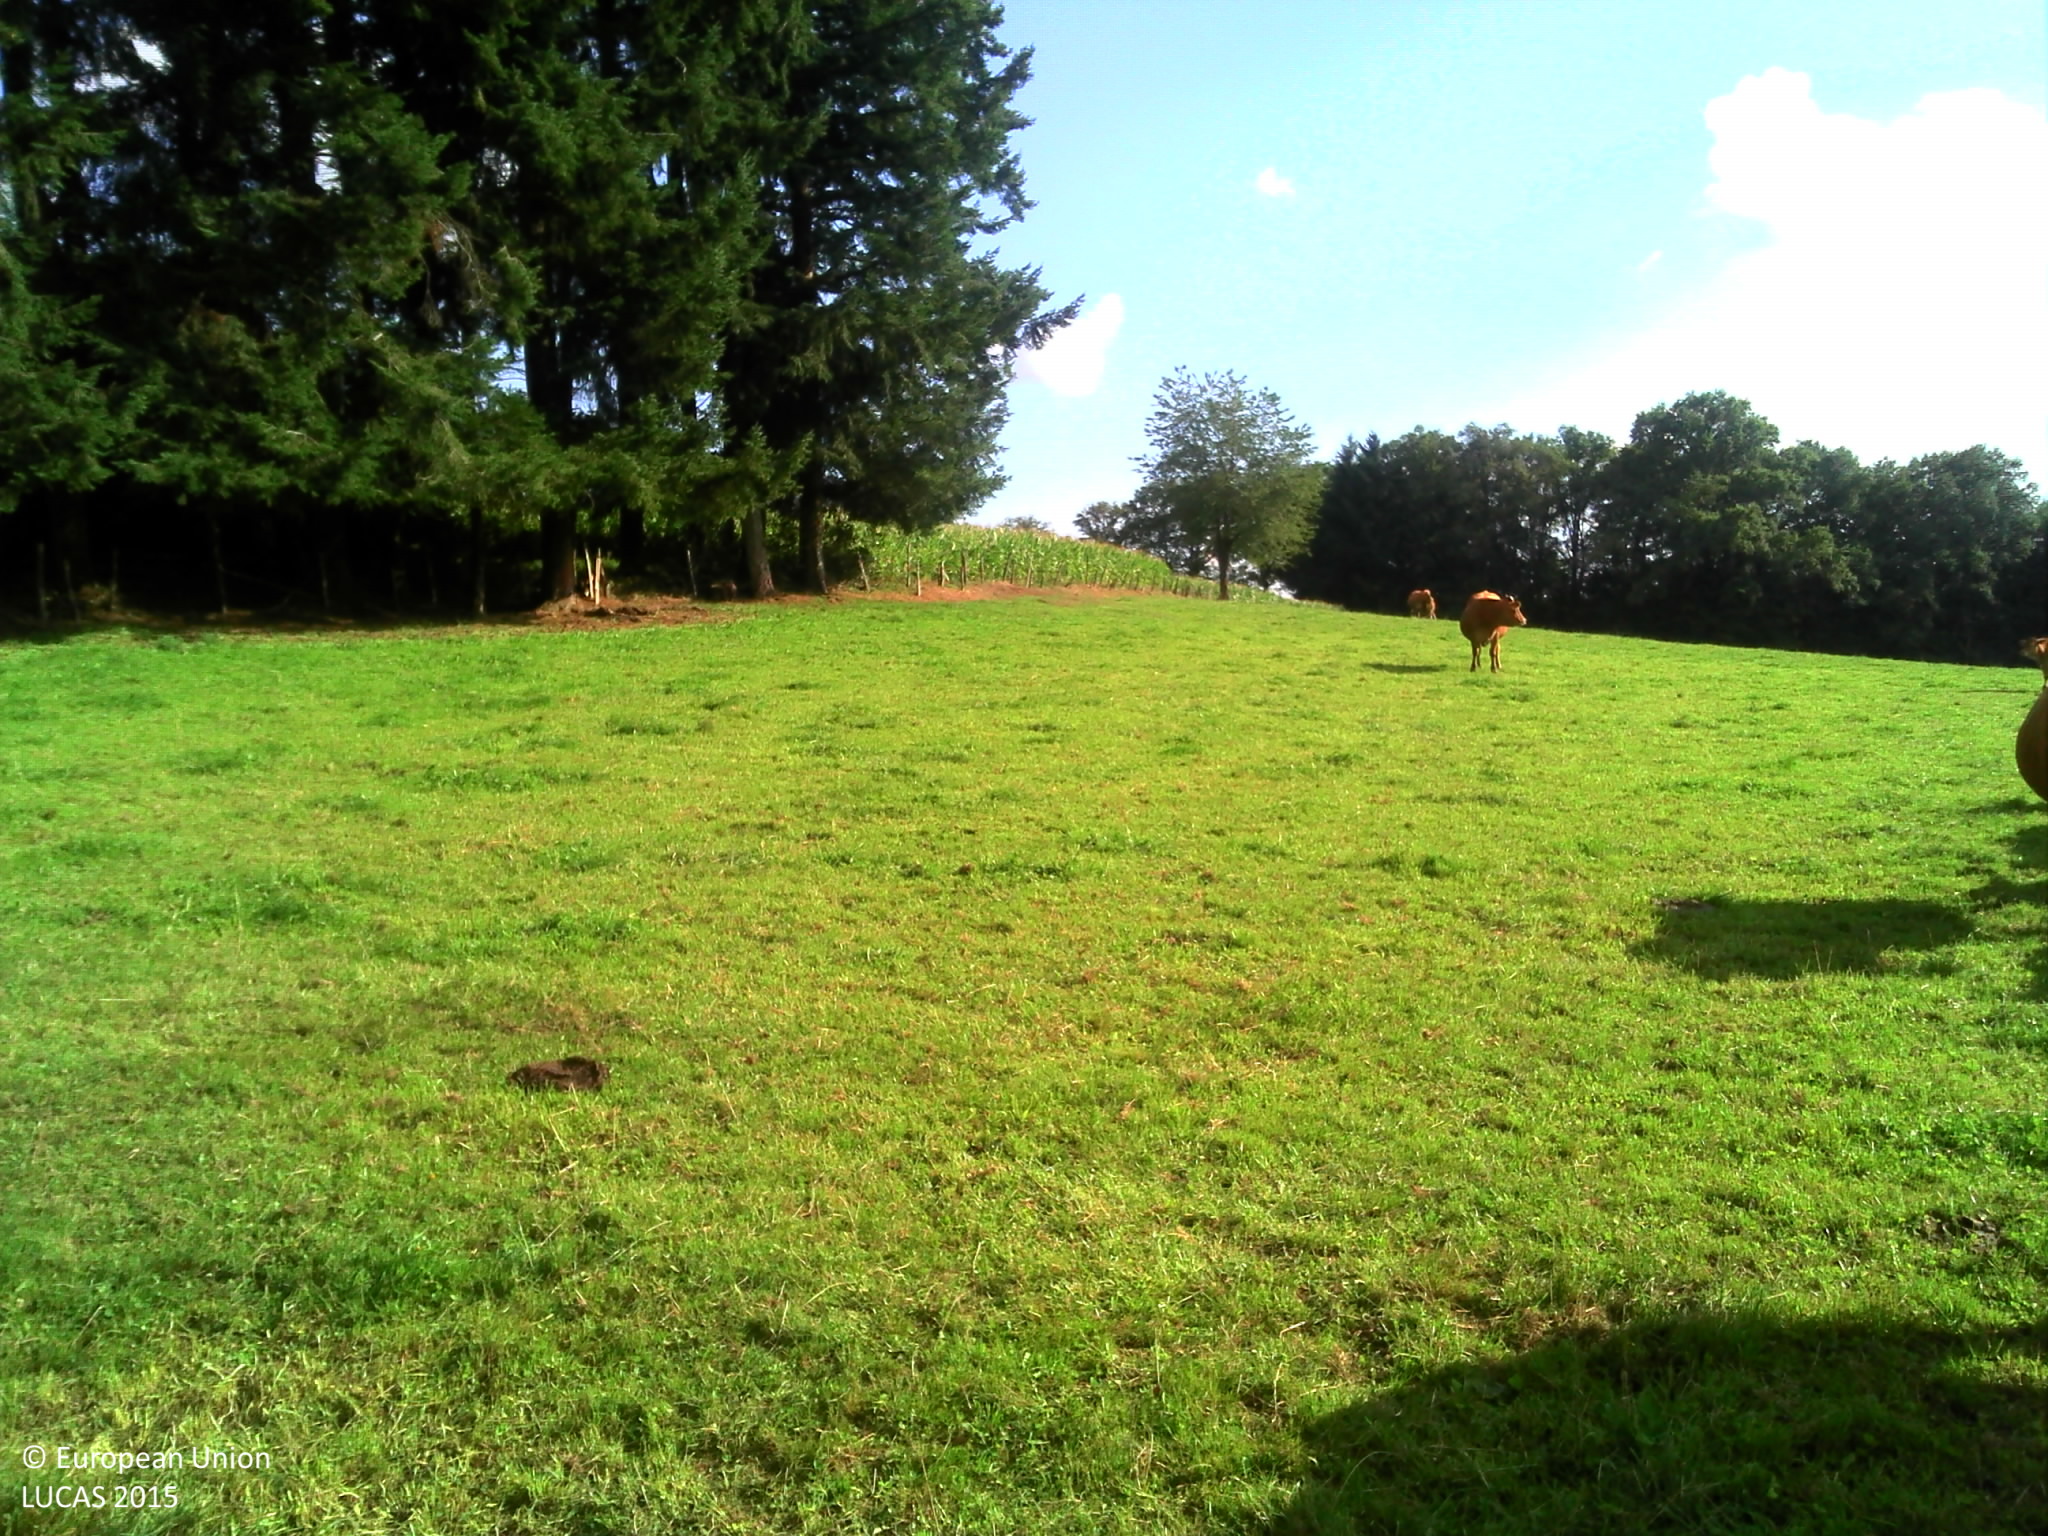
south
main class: Grassland
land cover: Grassland without tree/shrub cover
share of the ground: > 75 %
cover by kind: herbaceous plants 100 %
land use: Agriculture (excluding fallow land and kitchen gardens)
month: August
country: FR
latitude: 45.9238
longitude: 1.7536
